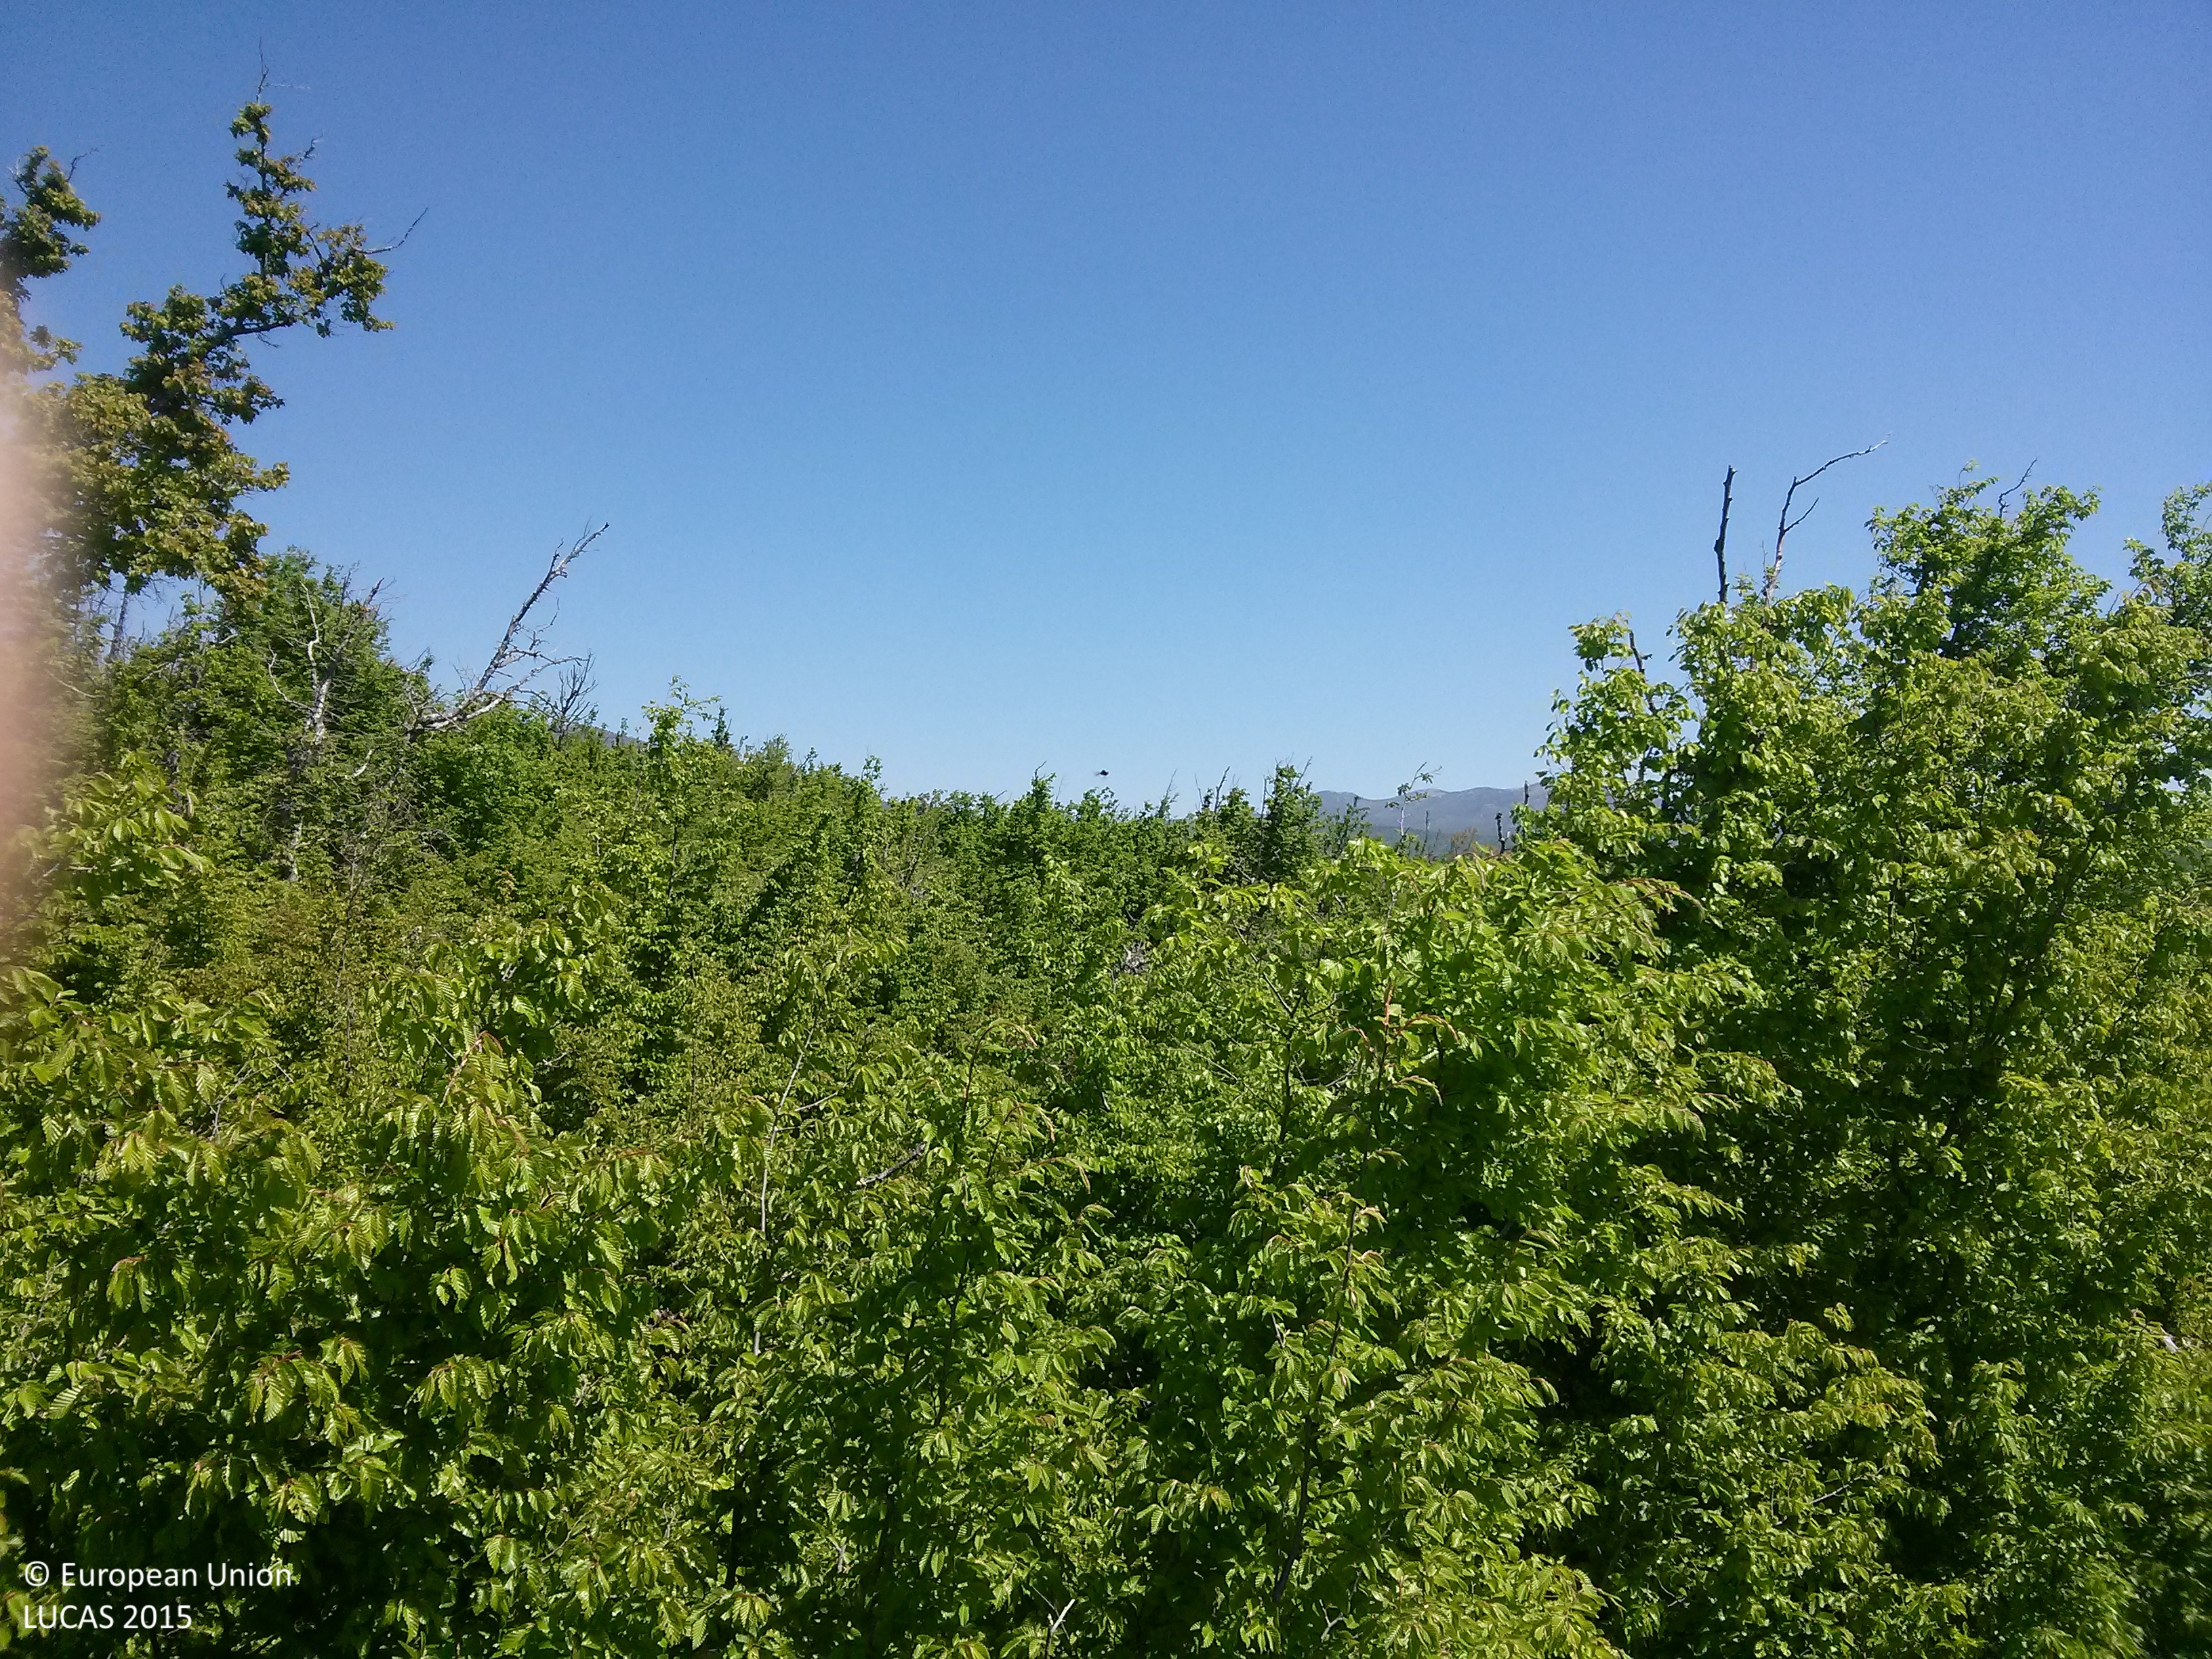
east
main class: Woodland
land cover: Broadleaved woodland
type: thermophilous deciduous forest
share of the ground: > 75 %
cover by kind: broadleaved forest trees 90 %, herbaceous plants 5 %, unconsolidated bare surface 5 %
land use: Semi-natural and natural areas not in use
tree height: < 5 m
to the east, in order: Broadleaved woodland
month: April
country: HR
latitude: 44.1656
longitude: 15.8828
